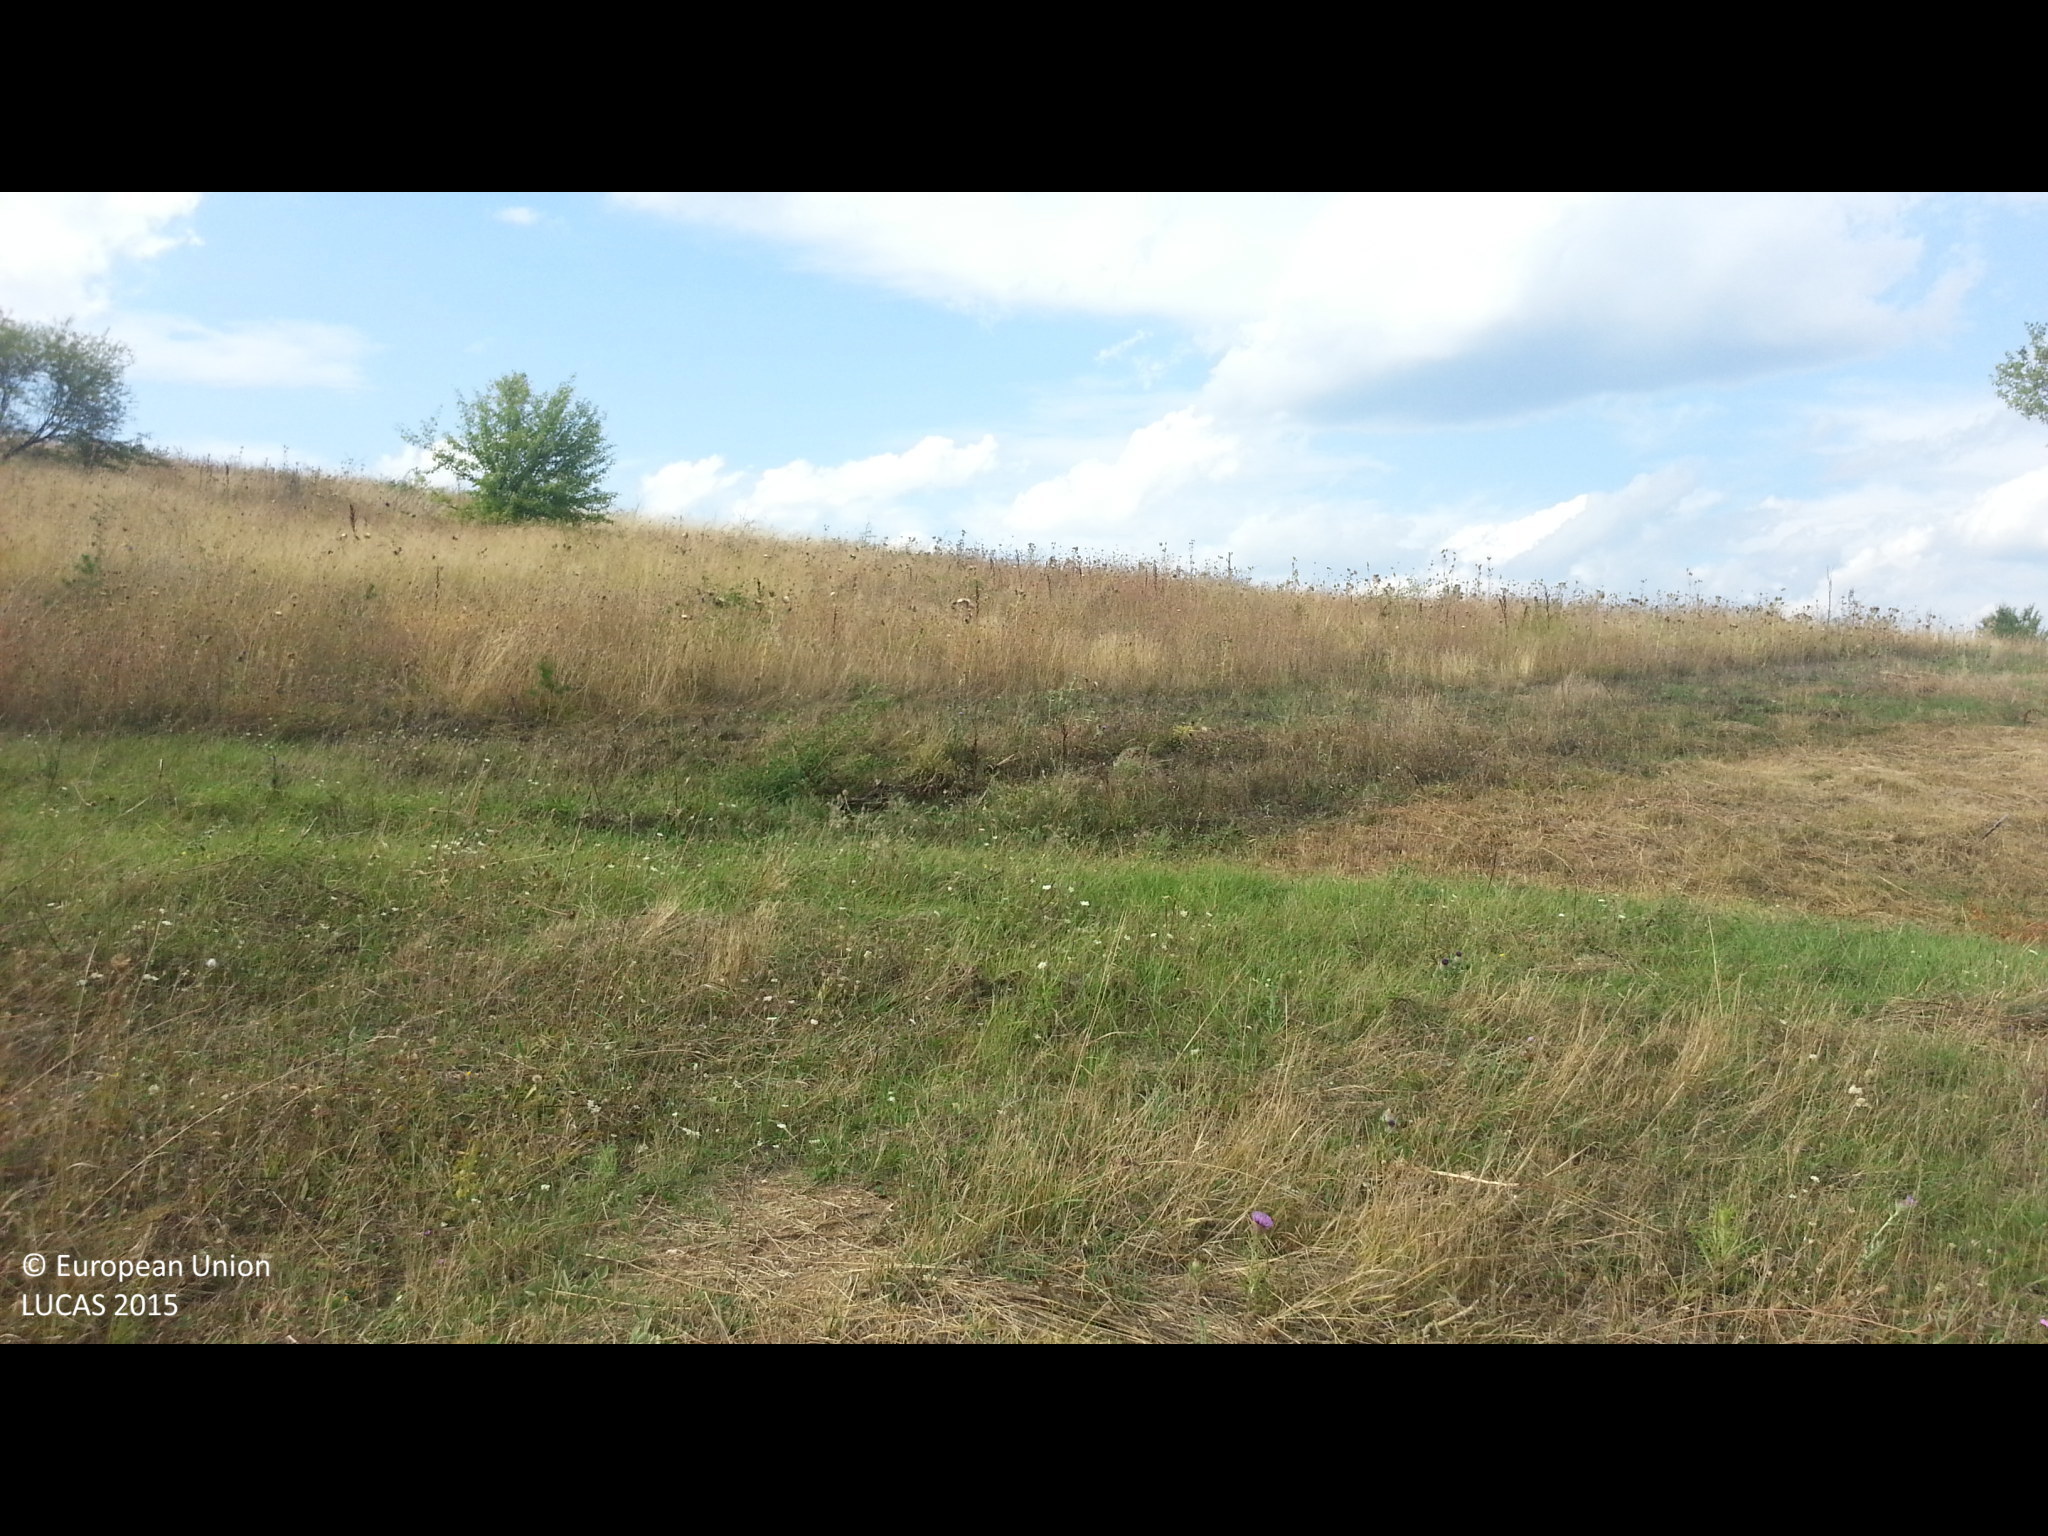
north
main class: Grassland
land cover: Grassland without tree/shrub cover
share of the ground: > 75 %
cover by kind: herbaceous plants 100 %
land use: Agriculture (excluding fallow land and kitchen gardens)
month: September
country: BG
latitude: 42.4649
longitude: 22.6099
